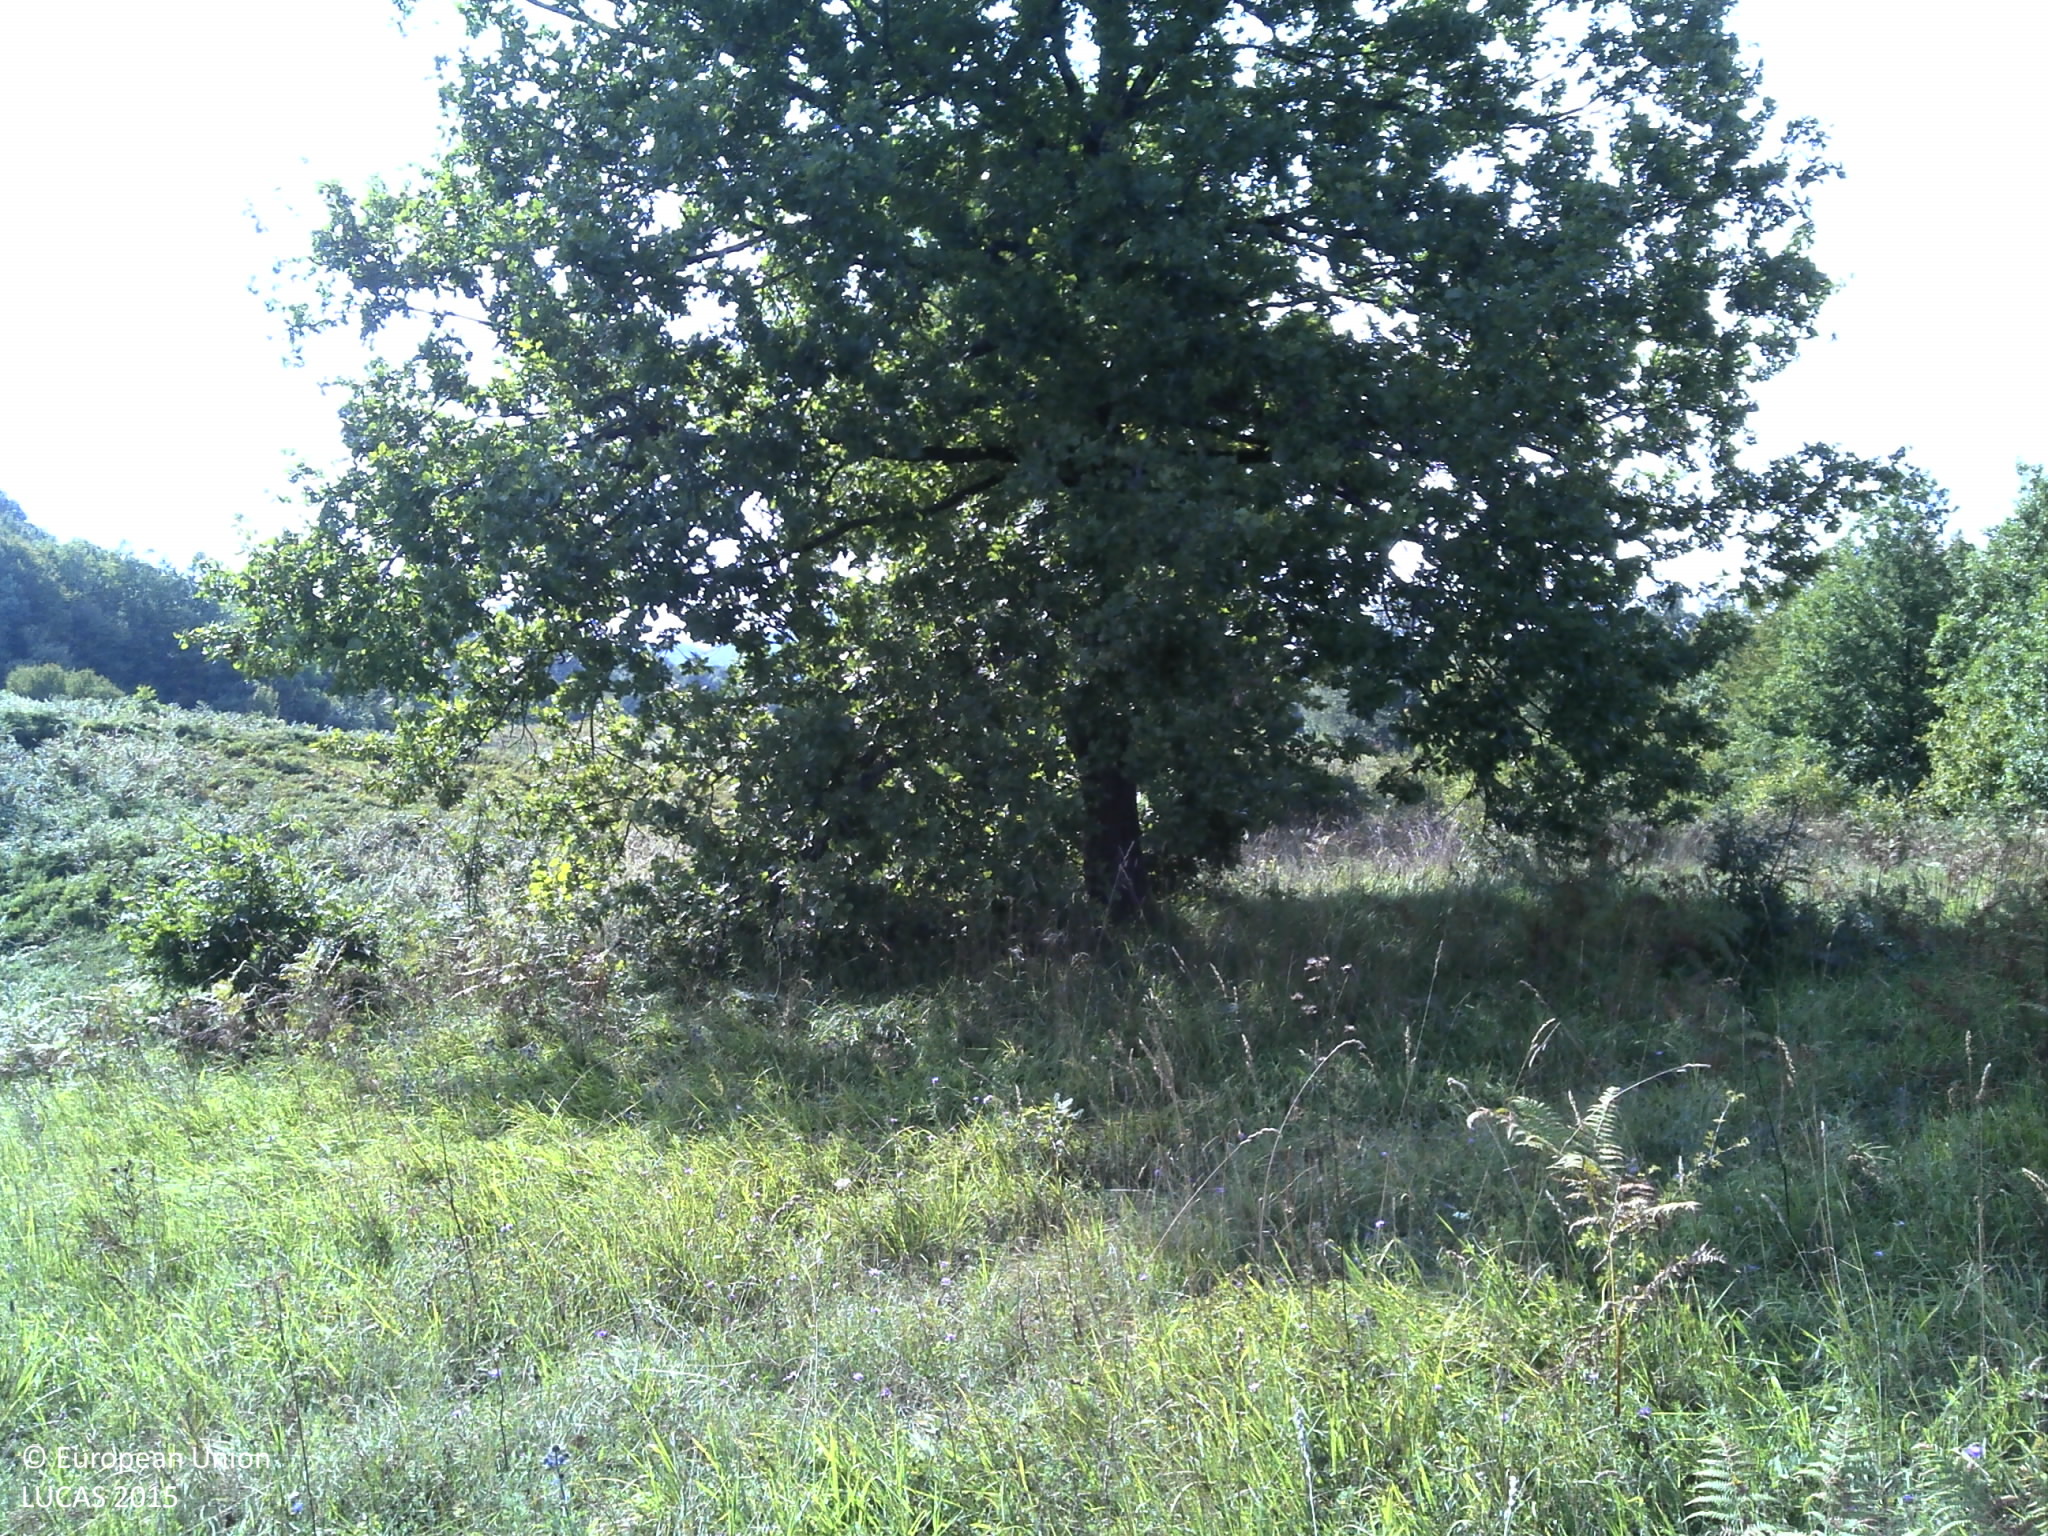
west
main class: Grassland
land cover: Grassland with sparse tree/shrub cover
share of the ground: > 75 %
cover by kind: herbaceous plants 95 %, broadleaved forest trees 5 %
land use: Semi-natural and natural areas not in use
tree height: < 5 m
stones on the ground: < 10 %
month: September
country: HR
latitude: 45.0988
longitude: 15.6757
